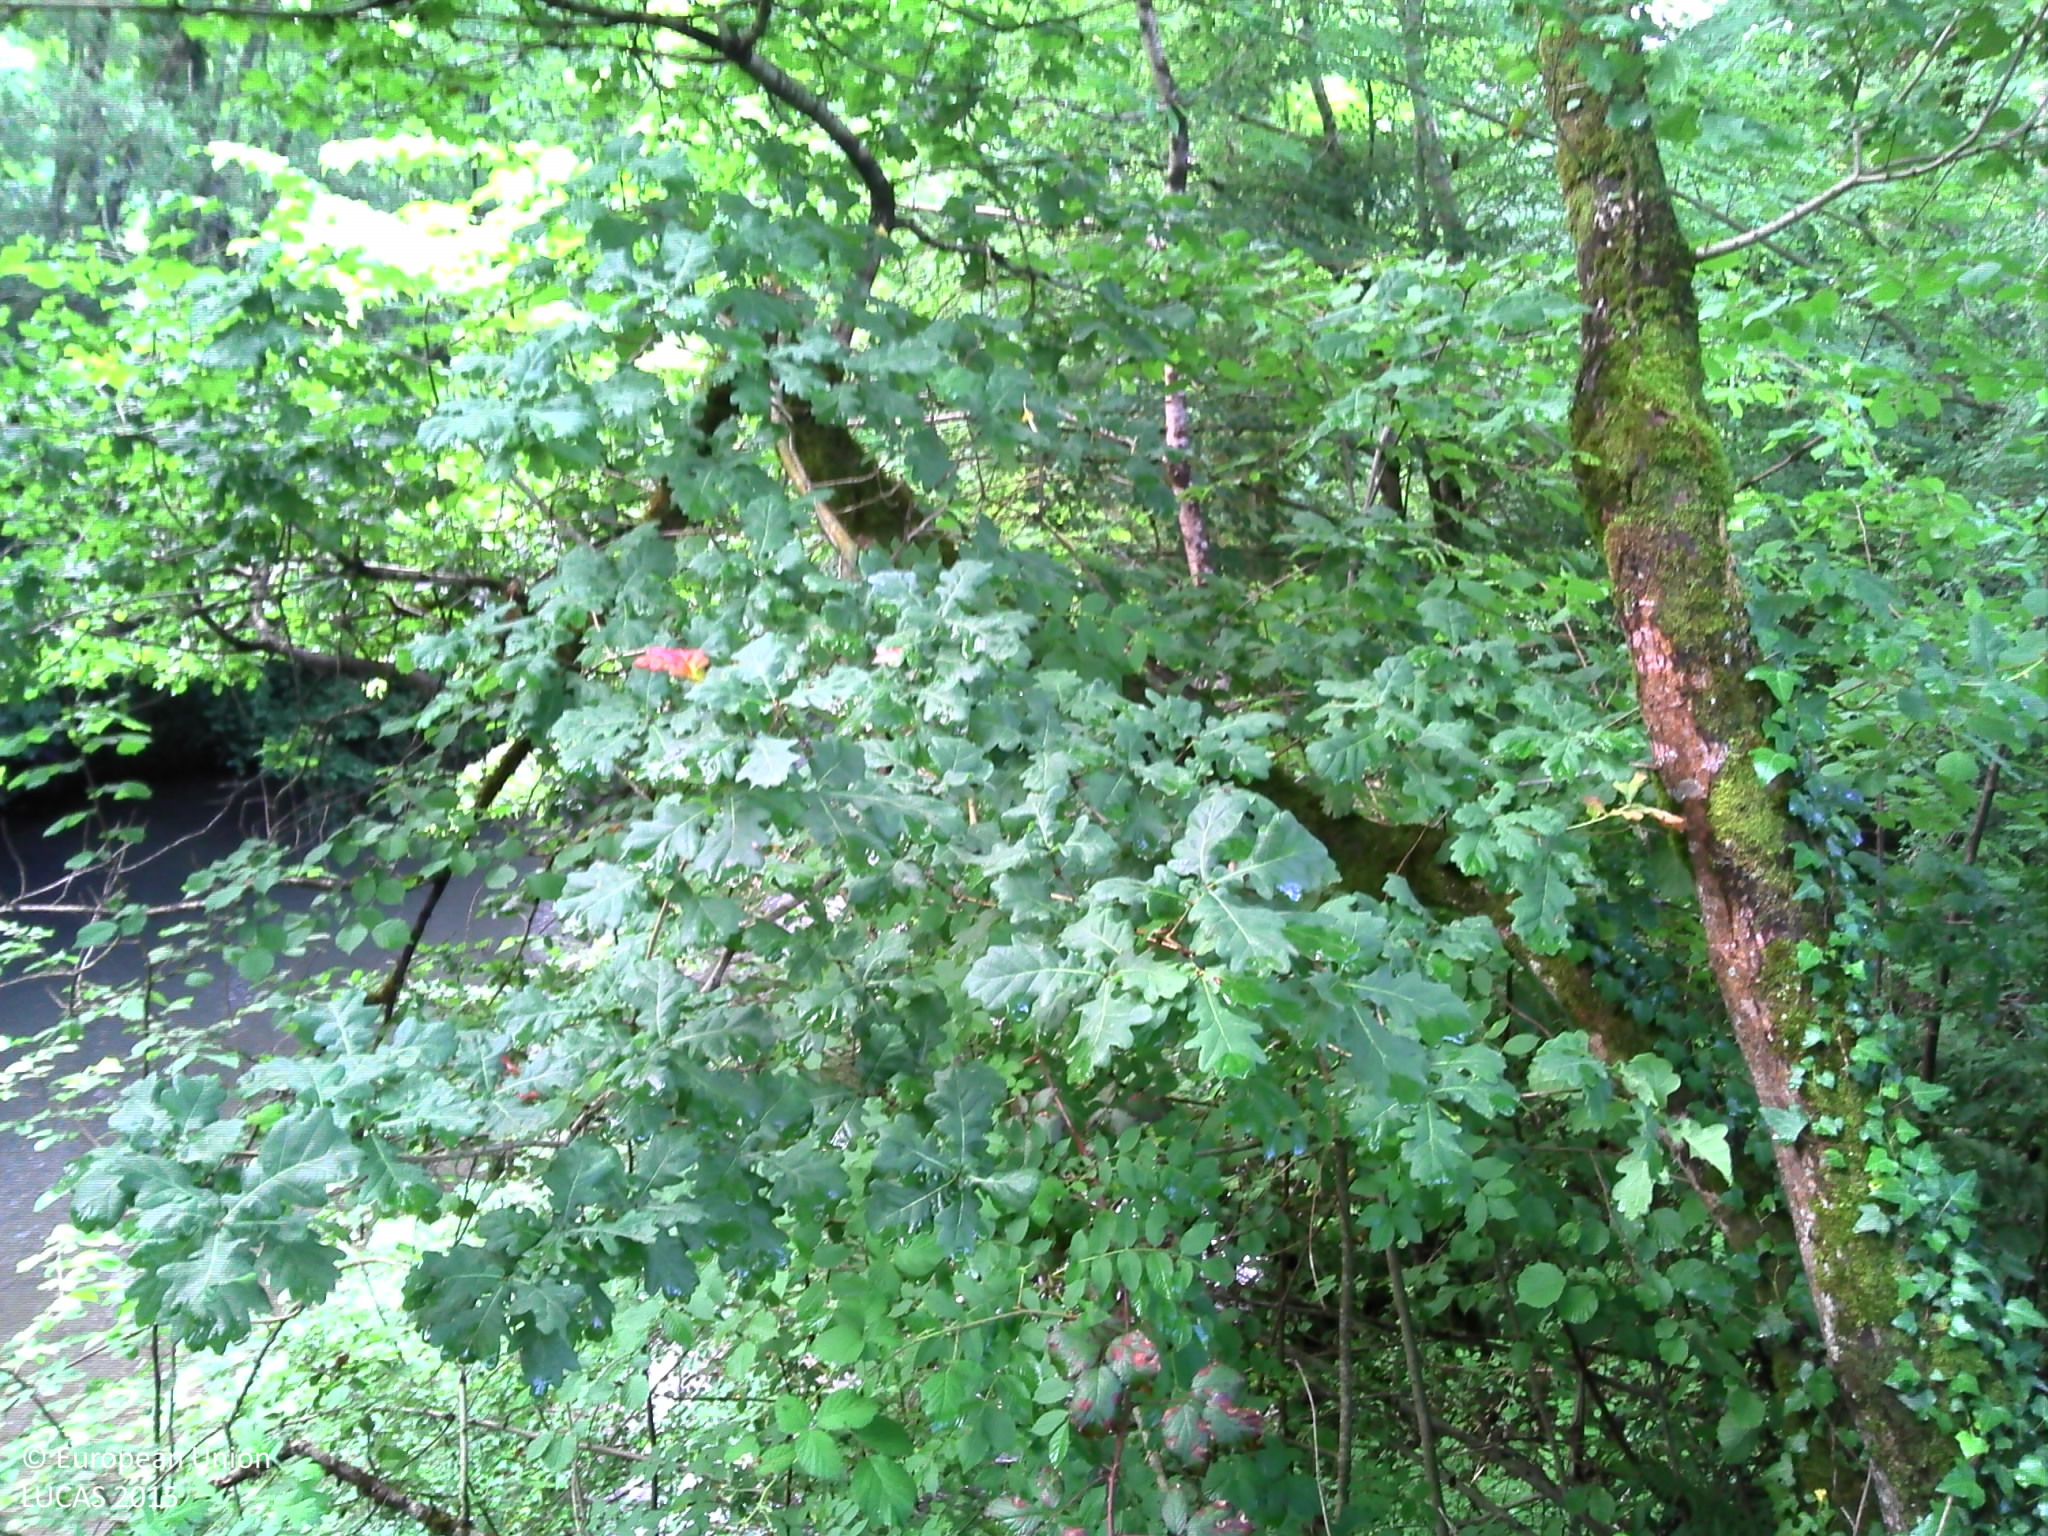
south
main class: Woodland
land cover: Broadleaved woodland
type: acidophilous oak and oak-birch forest
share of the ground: > 75 %
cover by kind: broadleaved forest trees 70 %, shrubs 10 %, herbaceous plants 10 %, lichens and mosses 10 %
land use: Forestry
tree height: > 5 m
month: June
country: FR
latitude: 43.2183
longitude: -0.6570
